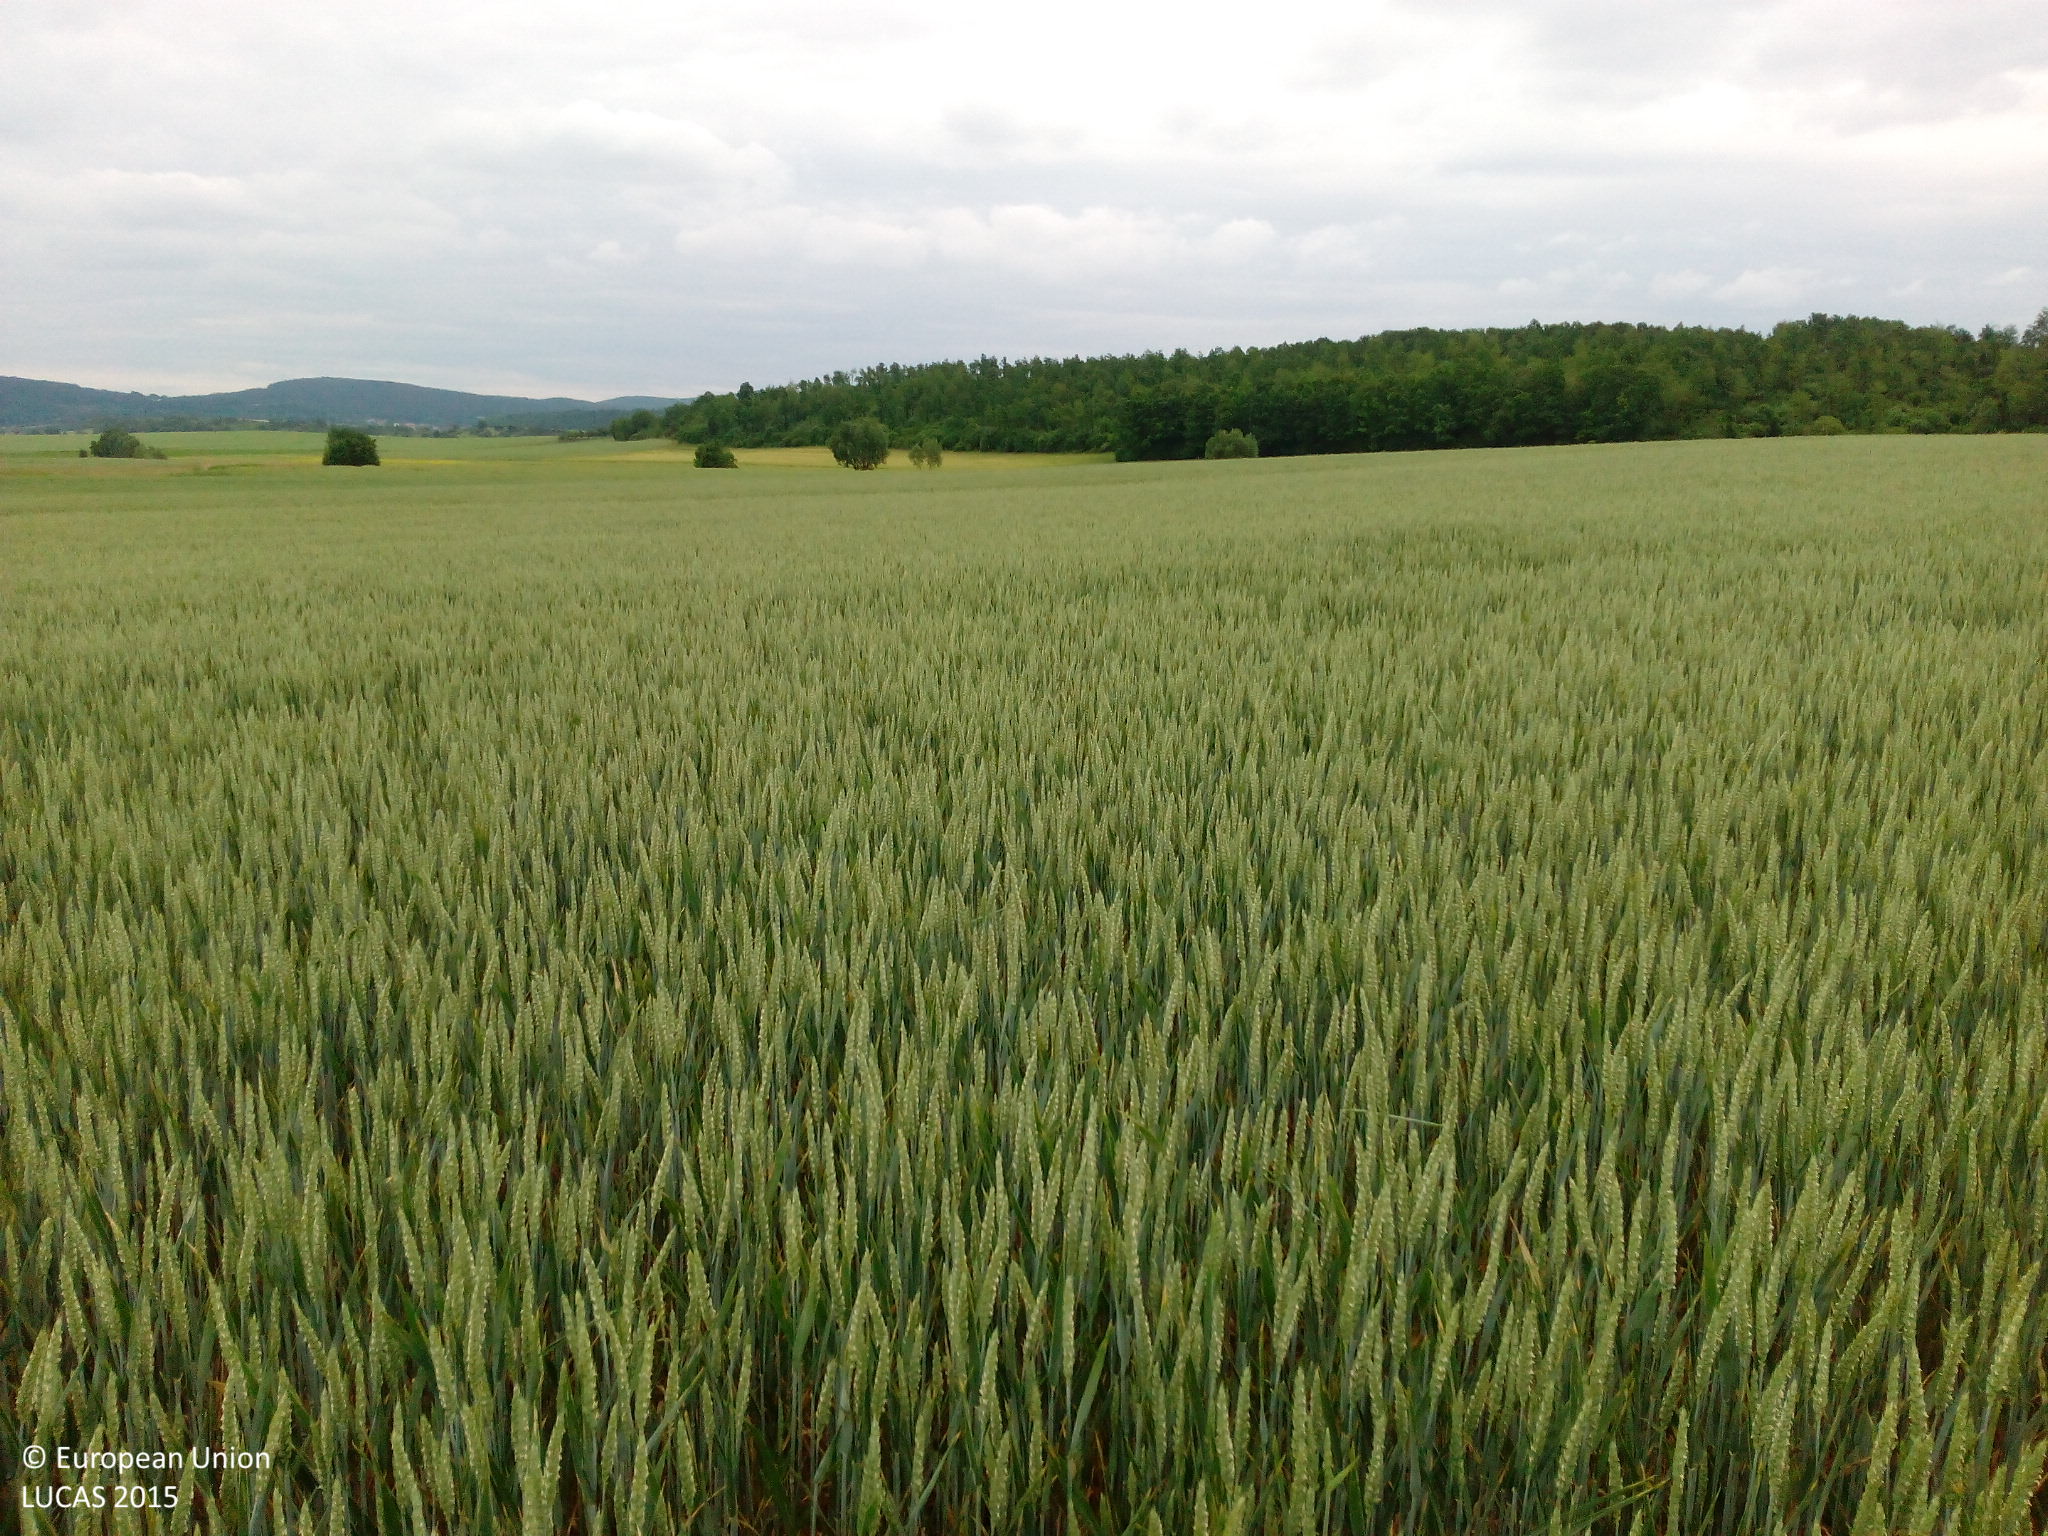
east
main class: Cropland
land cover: Common wheat
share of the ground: > 75 %
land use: Agriculture (excluding fallow land and kitchen gardens)
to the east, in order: Common wheat; Tracks; Grassland without tree/shrub cover; Rape and turnip rape
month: June
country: DE
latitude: 50.2556
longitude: 10.3505
